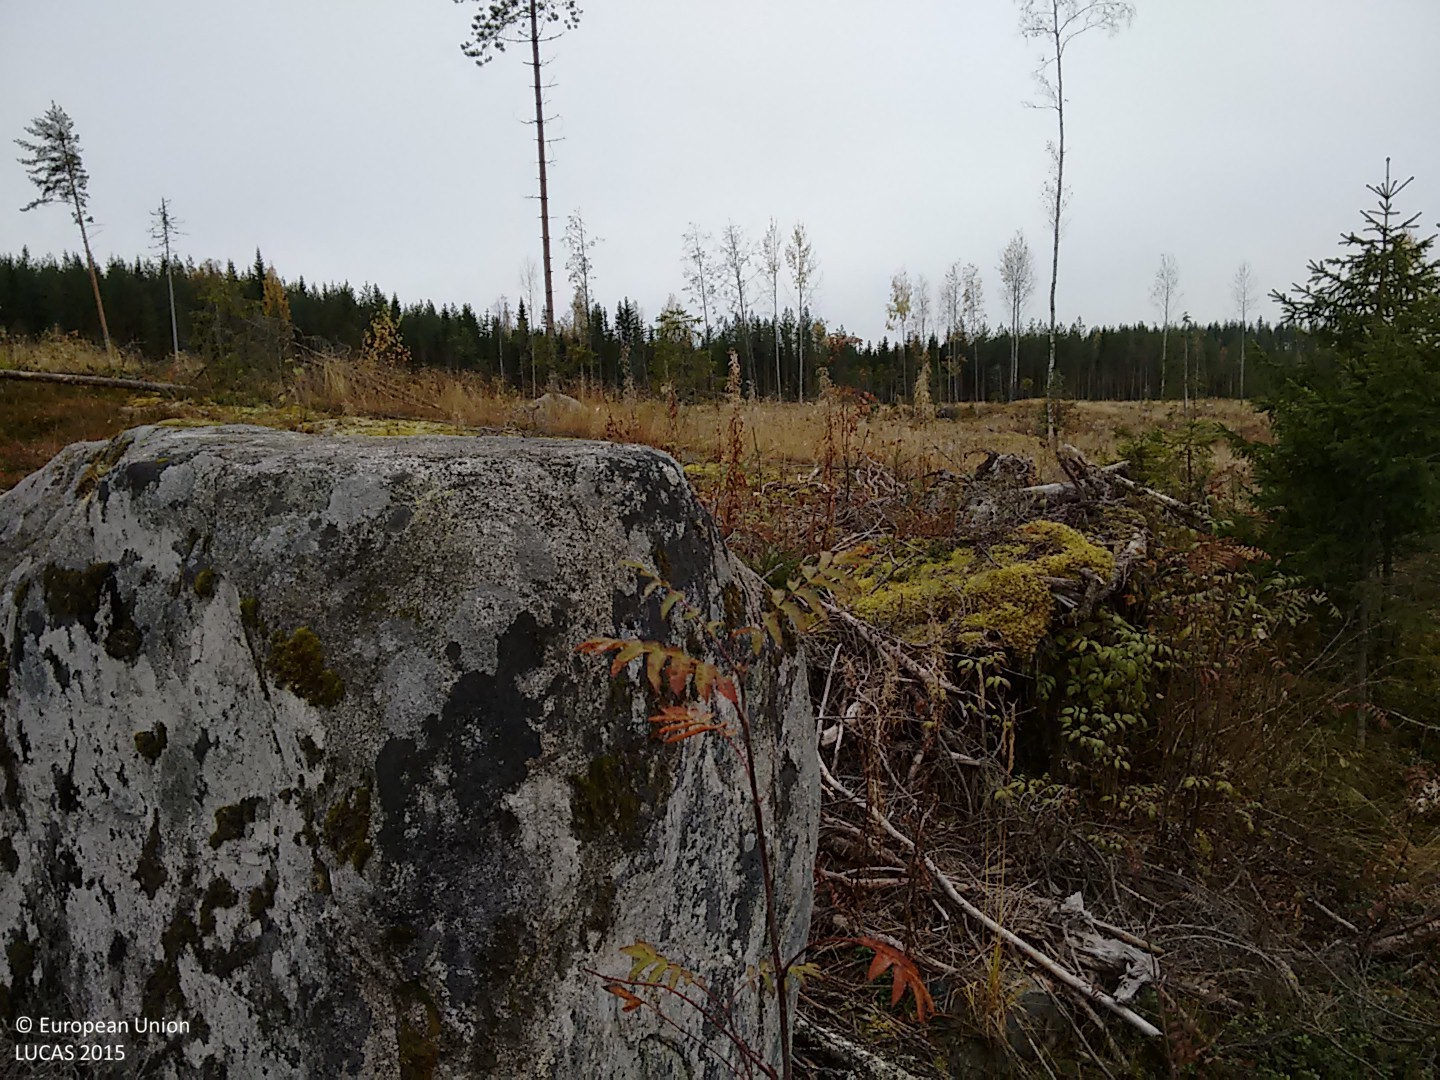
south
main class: Woodland
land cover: Other mixed woodland
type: boreal forest
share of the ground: 50 - 75 %
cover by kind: coniferous forest trees 35 %, broadleaved forest trees 35 %, herbaceous plants 15 %, shrubs 10 %, unconsolidated bare surface 5 %
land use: Forestry
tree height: < 5 m
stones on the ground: > 50 %
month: October
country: FI
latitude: 62.7051
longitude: 26.3754
